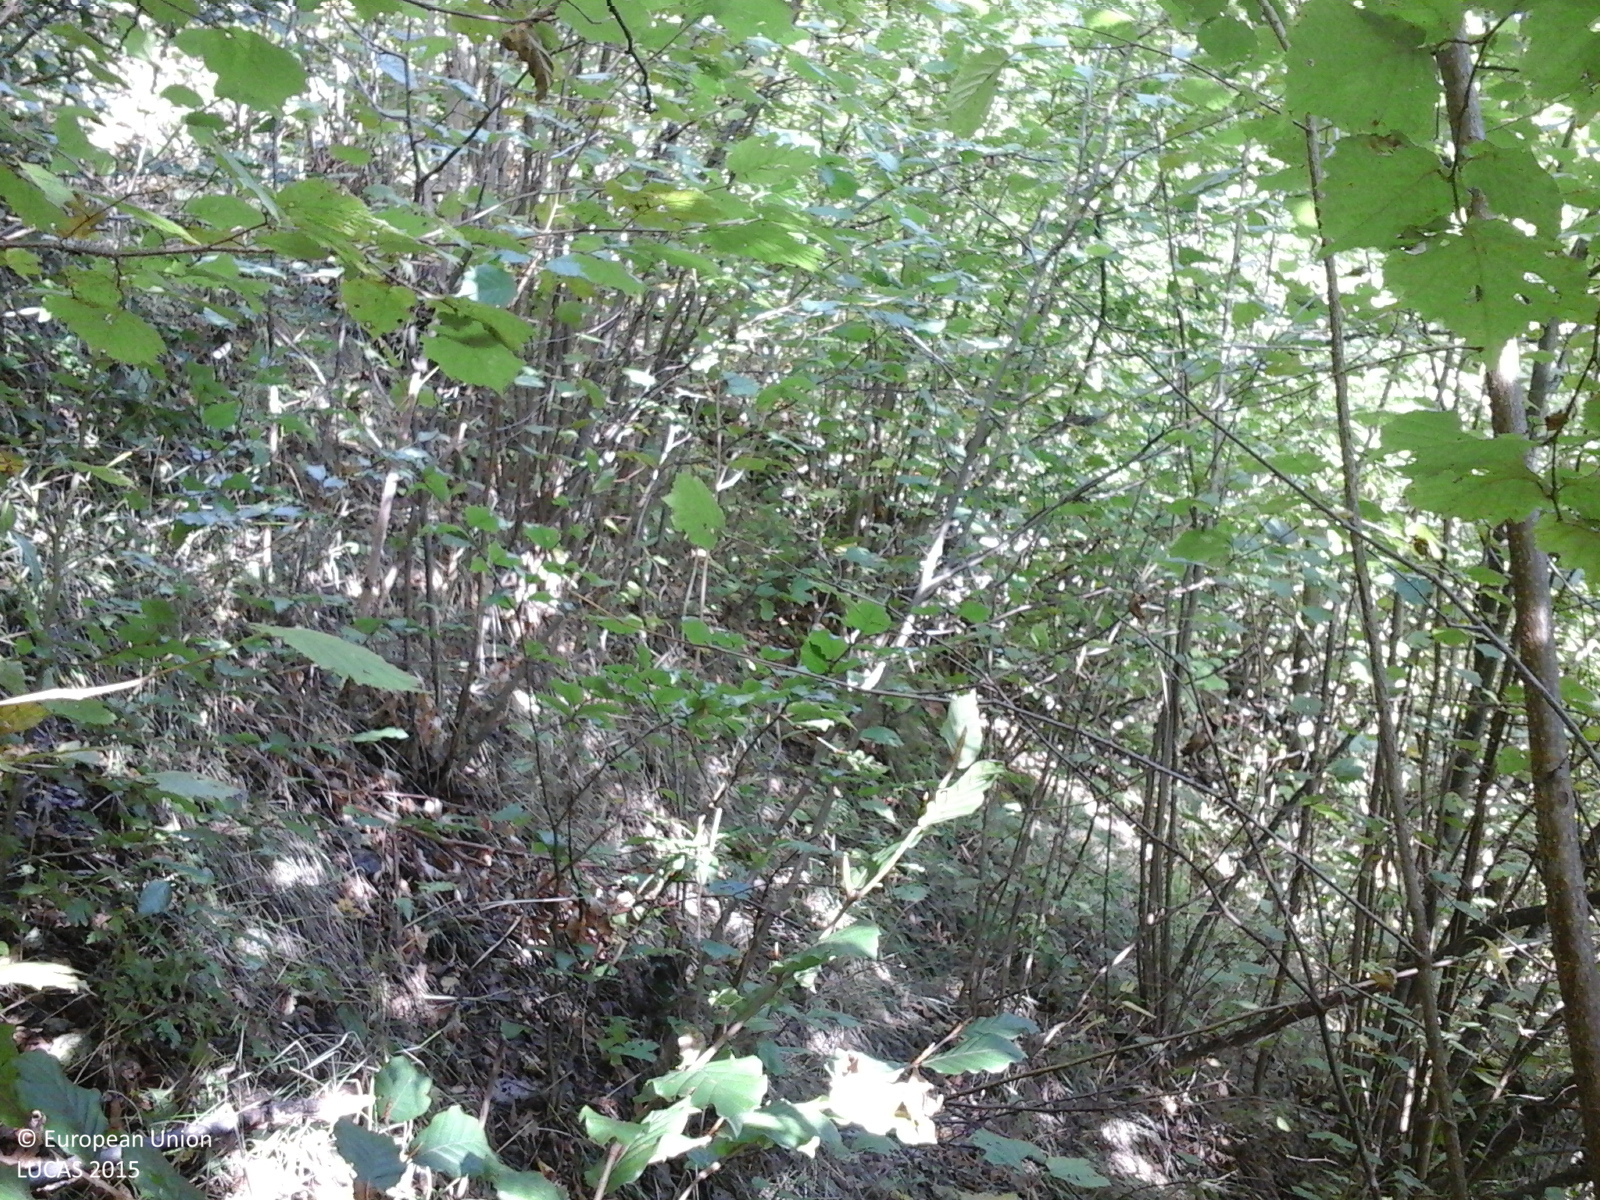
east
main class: Woodland
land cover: Broadleaved woodland
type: mesophytic deciduous forest
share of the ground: > 75 %
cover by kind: broadleaved forest trees 100 %
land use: Forestry
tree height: < 5 m
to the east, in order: Broadleaved woodland; Other mixed woodland
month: October
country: RO
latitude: 46.5524
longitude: 23.3296
